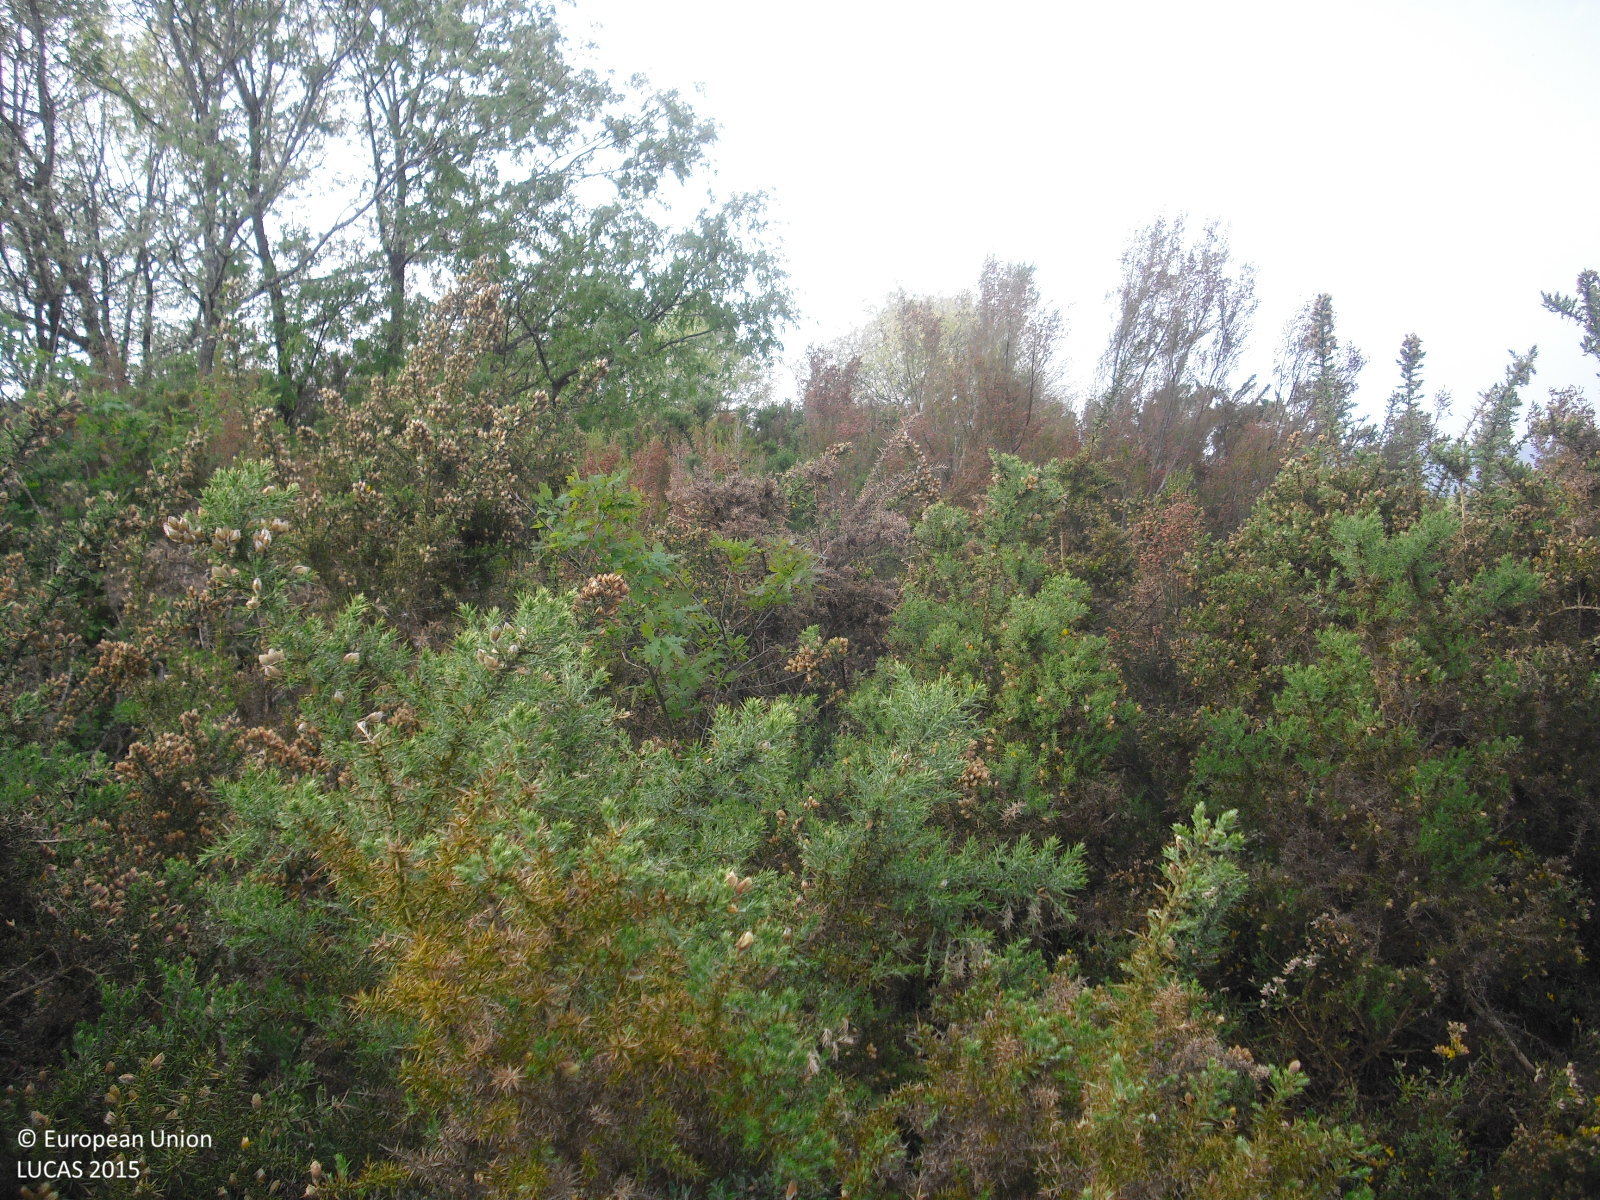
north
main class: Shrubland
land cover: Shrubland with sparse tree cover
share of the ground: > 75 %
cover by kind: shrubs 95 %, broadleaved forest trees 5 %
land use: Semi-natural and natural areas not in use
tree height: < 5 m
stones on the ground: 10 - 25 %
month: May
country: ES
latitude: 42.1668
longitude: -7.6070
